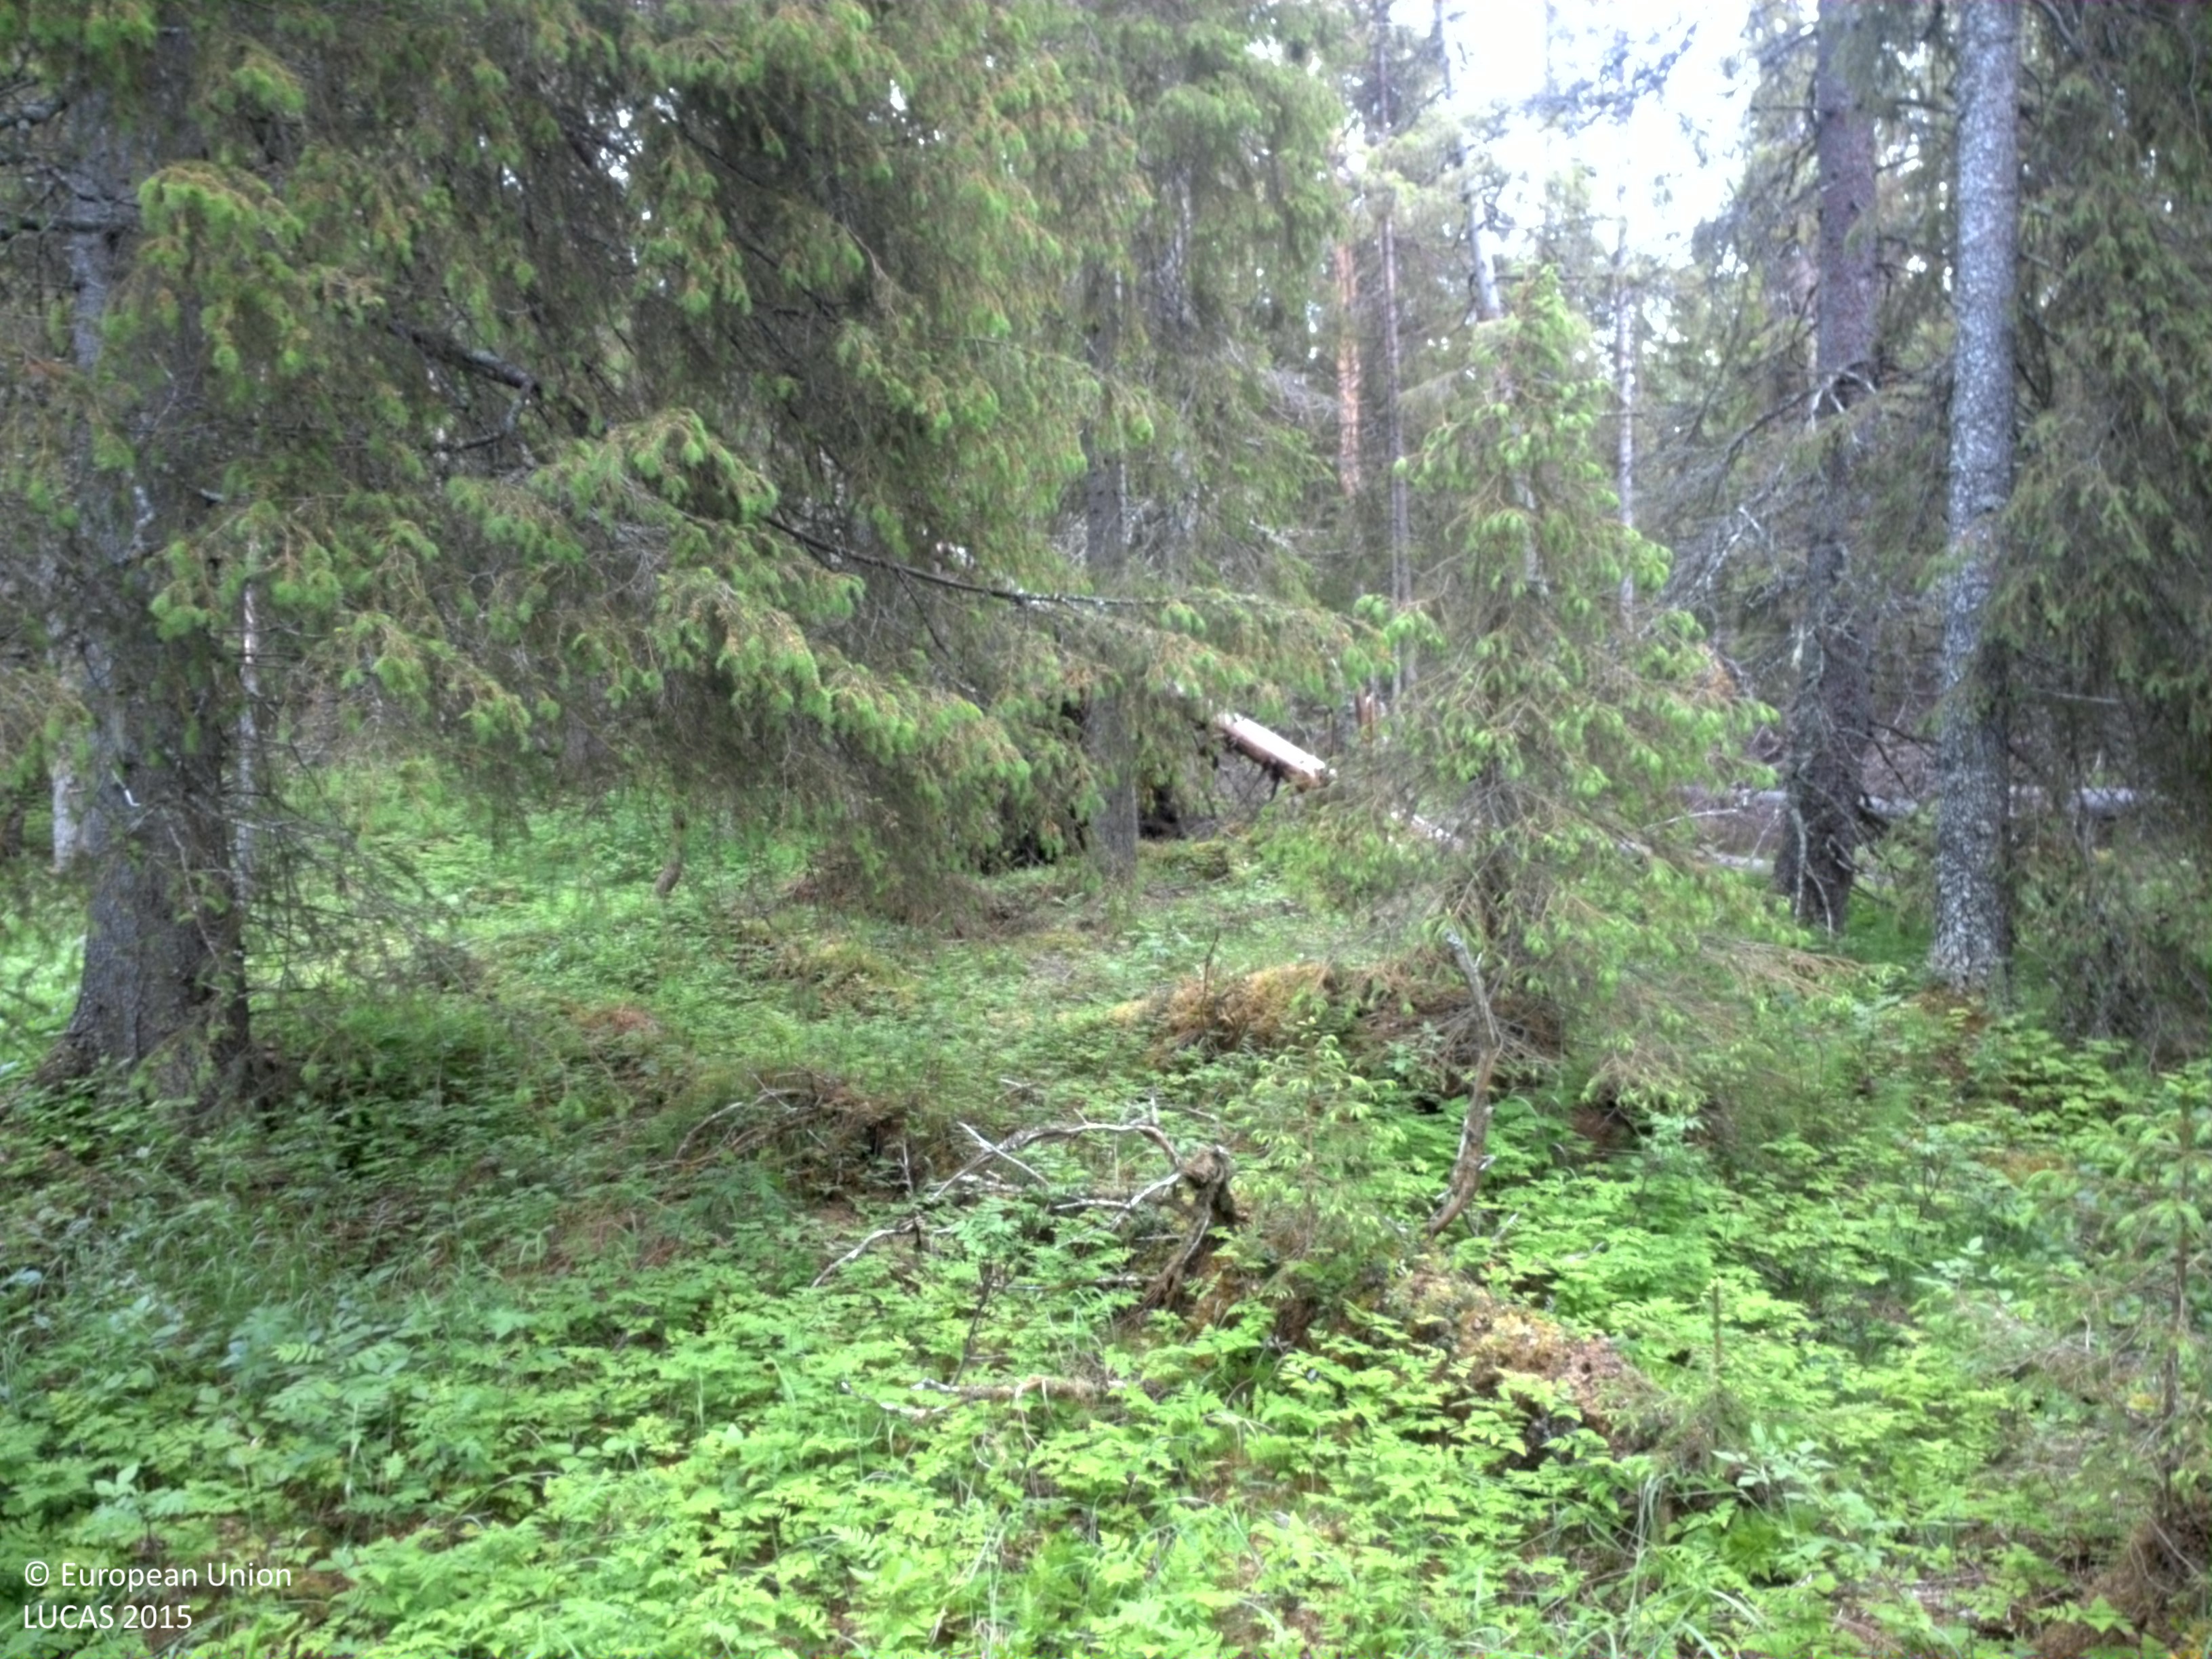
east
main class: Woodland
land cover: Spruce dominated coniferous woodland
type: boreal forest
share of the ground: 50 - 75 %
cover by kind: coniferous forest trees 70 %, herbaceous plants 25 %, broadleaved forest trees 5 %
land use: Forestry
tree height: > 5 m
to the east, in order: Spruce dominated coniferous woodland; Ditches and canals; Spruce dominated coniferous woodland; Spruce dominated mixed woodland; Ditches and canals; Spruce dominated mixed woodland; Ditches and canals; Grassland with sparse tree/shrub cover; Other mixed woodland
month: July
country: SE
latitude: 64.5175
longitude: 18.1128
